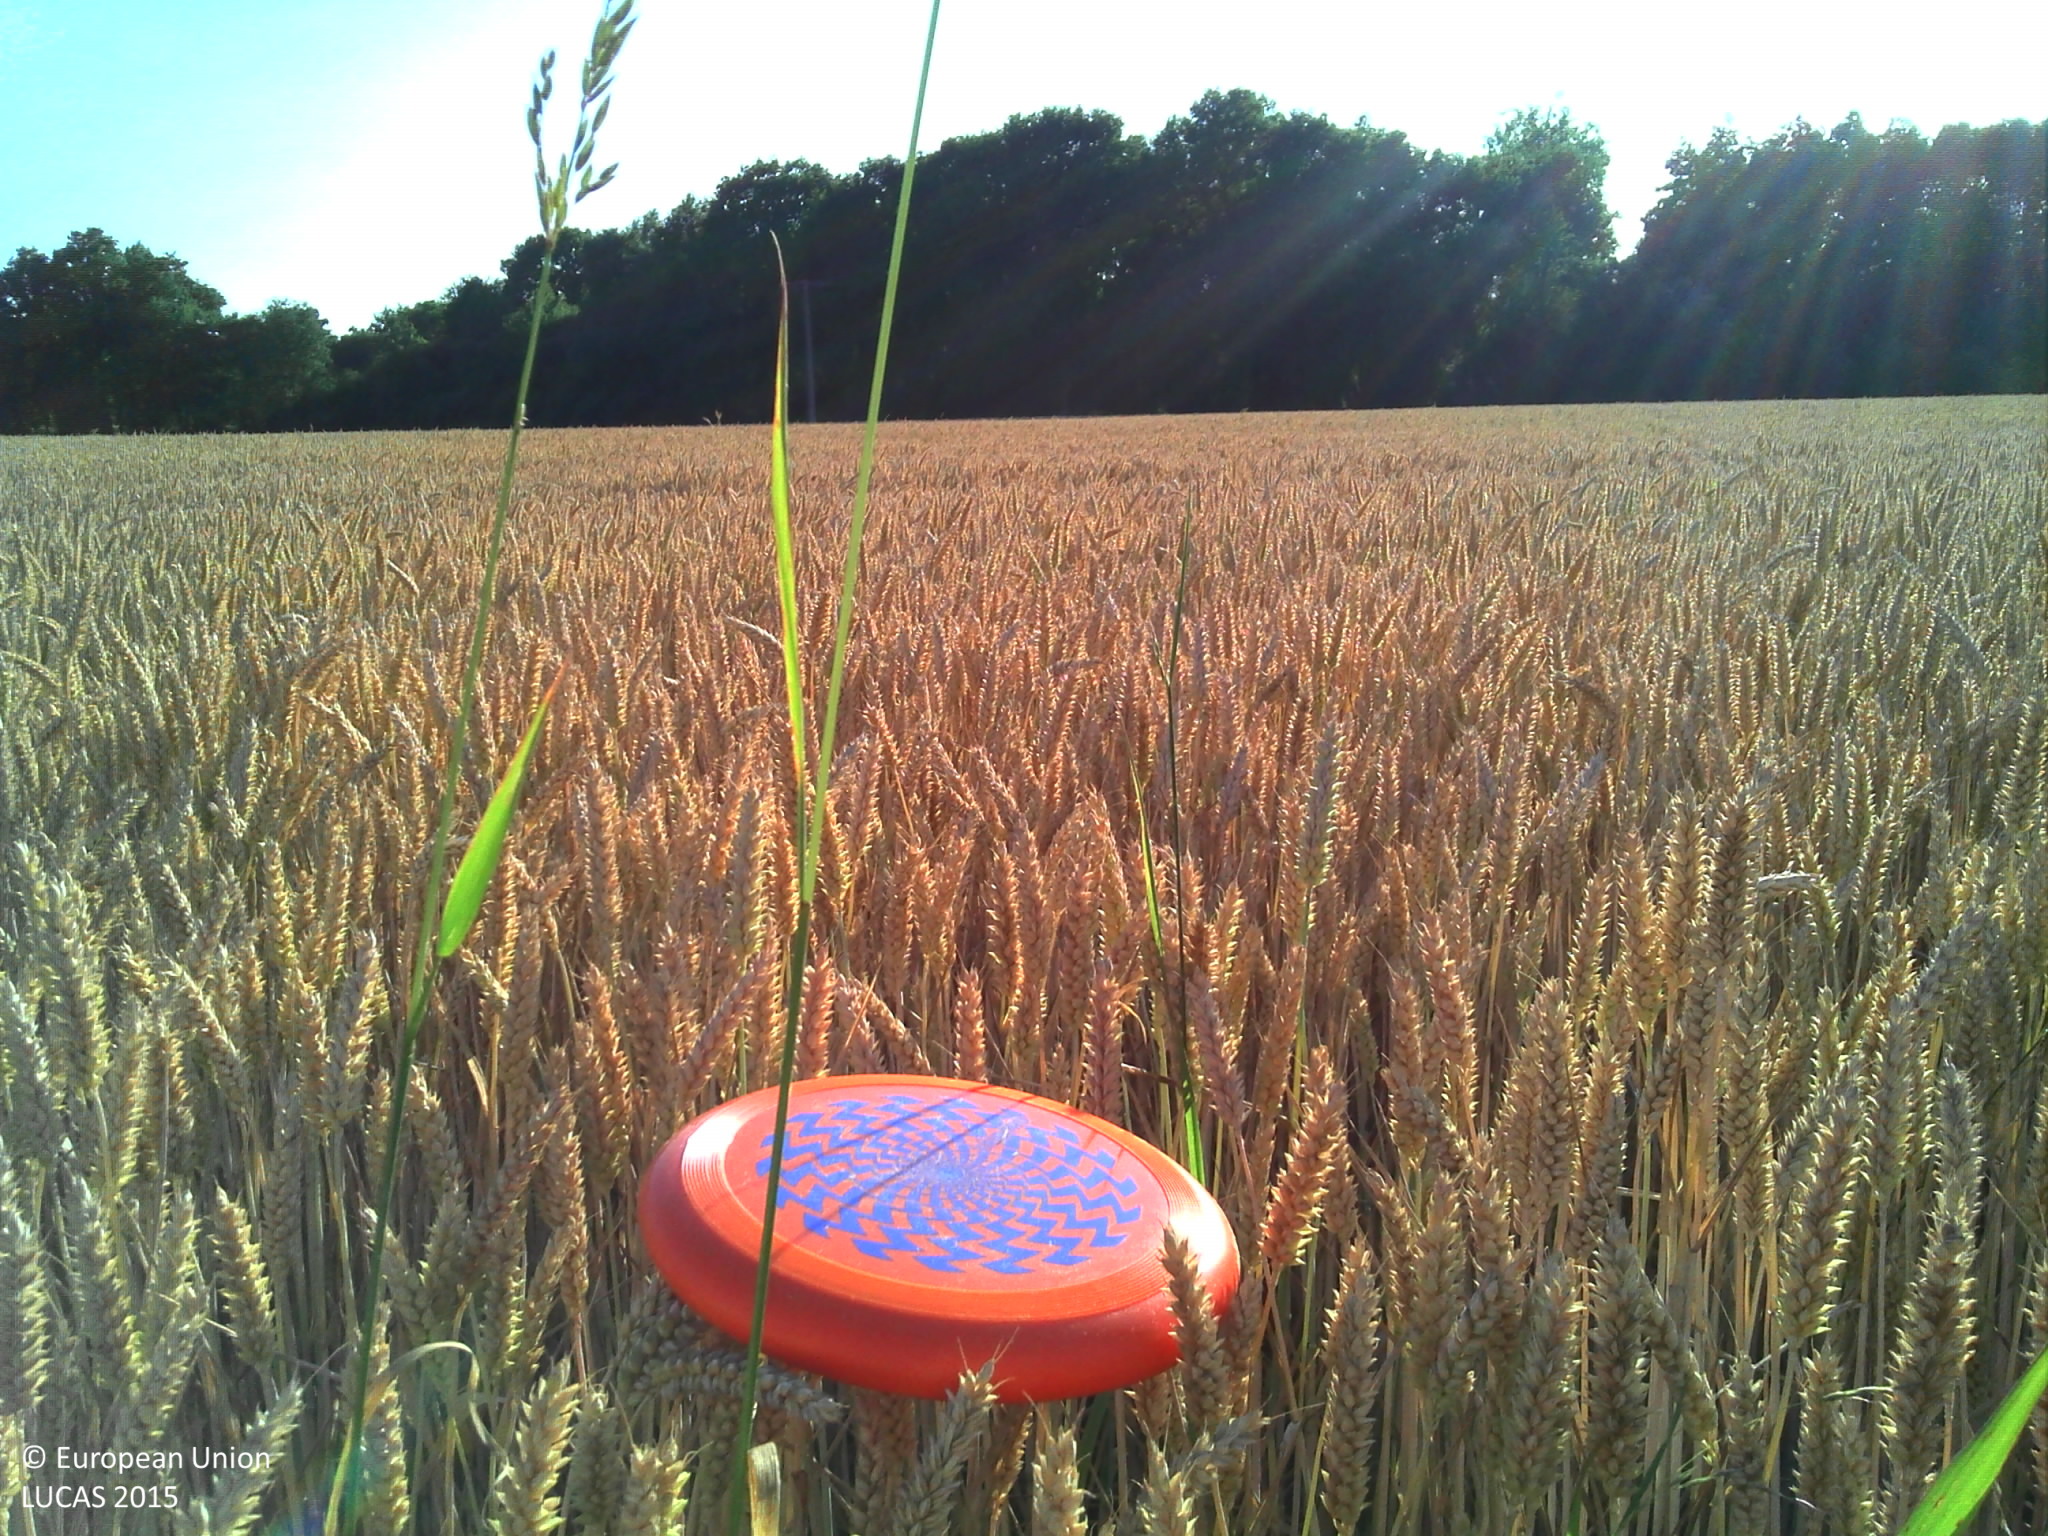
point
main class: Cropland
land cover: Common wheat
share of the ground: > 75 %
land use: Agriculture (excluding fallow land and kitchen gardens)
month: July
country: FR
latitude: 48.4337
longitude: -2.2079
